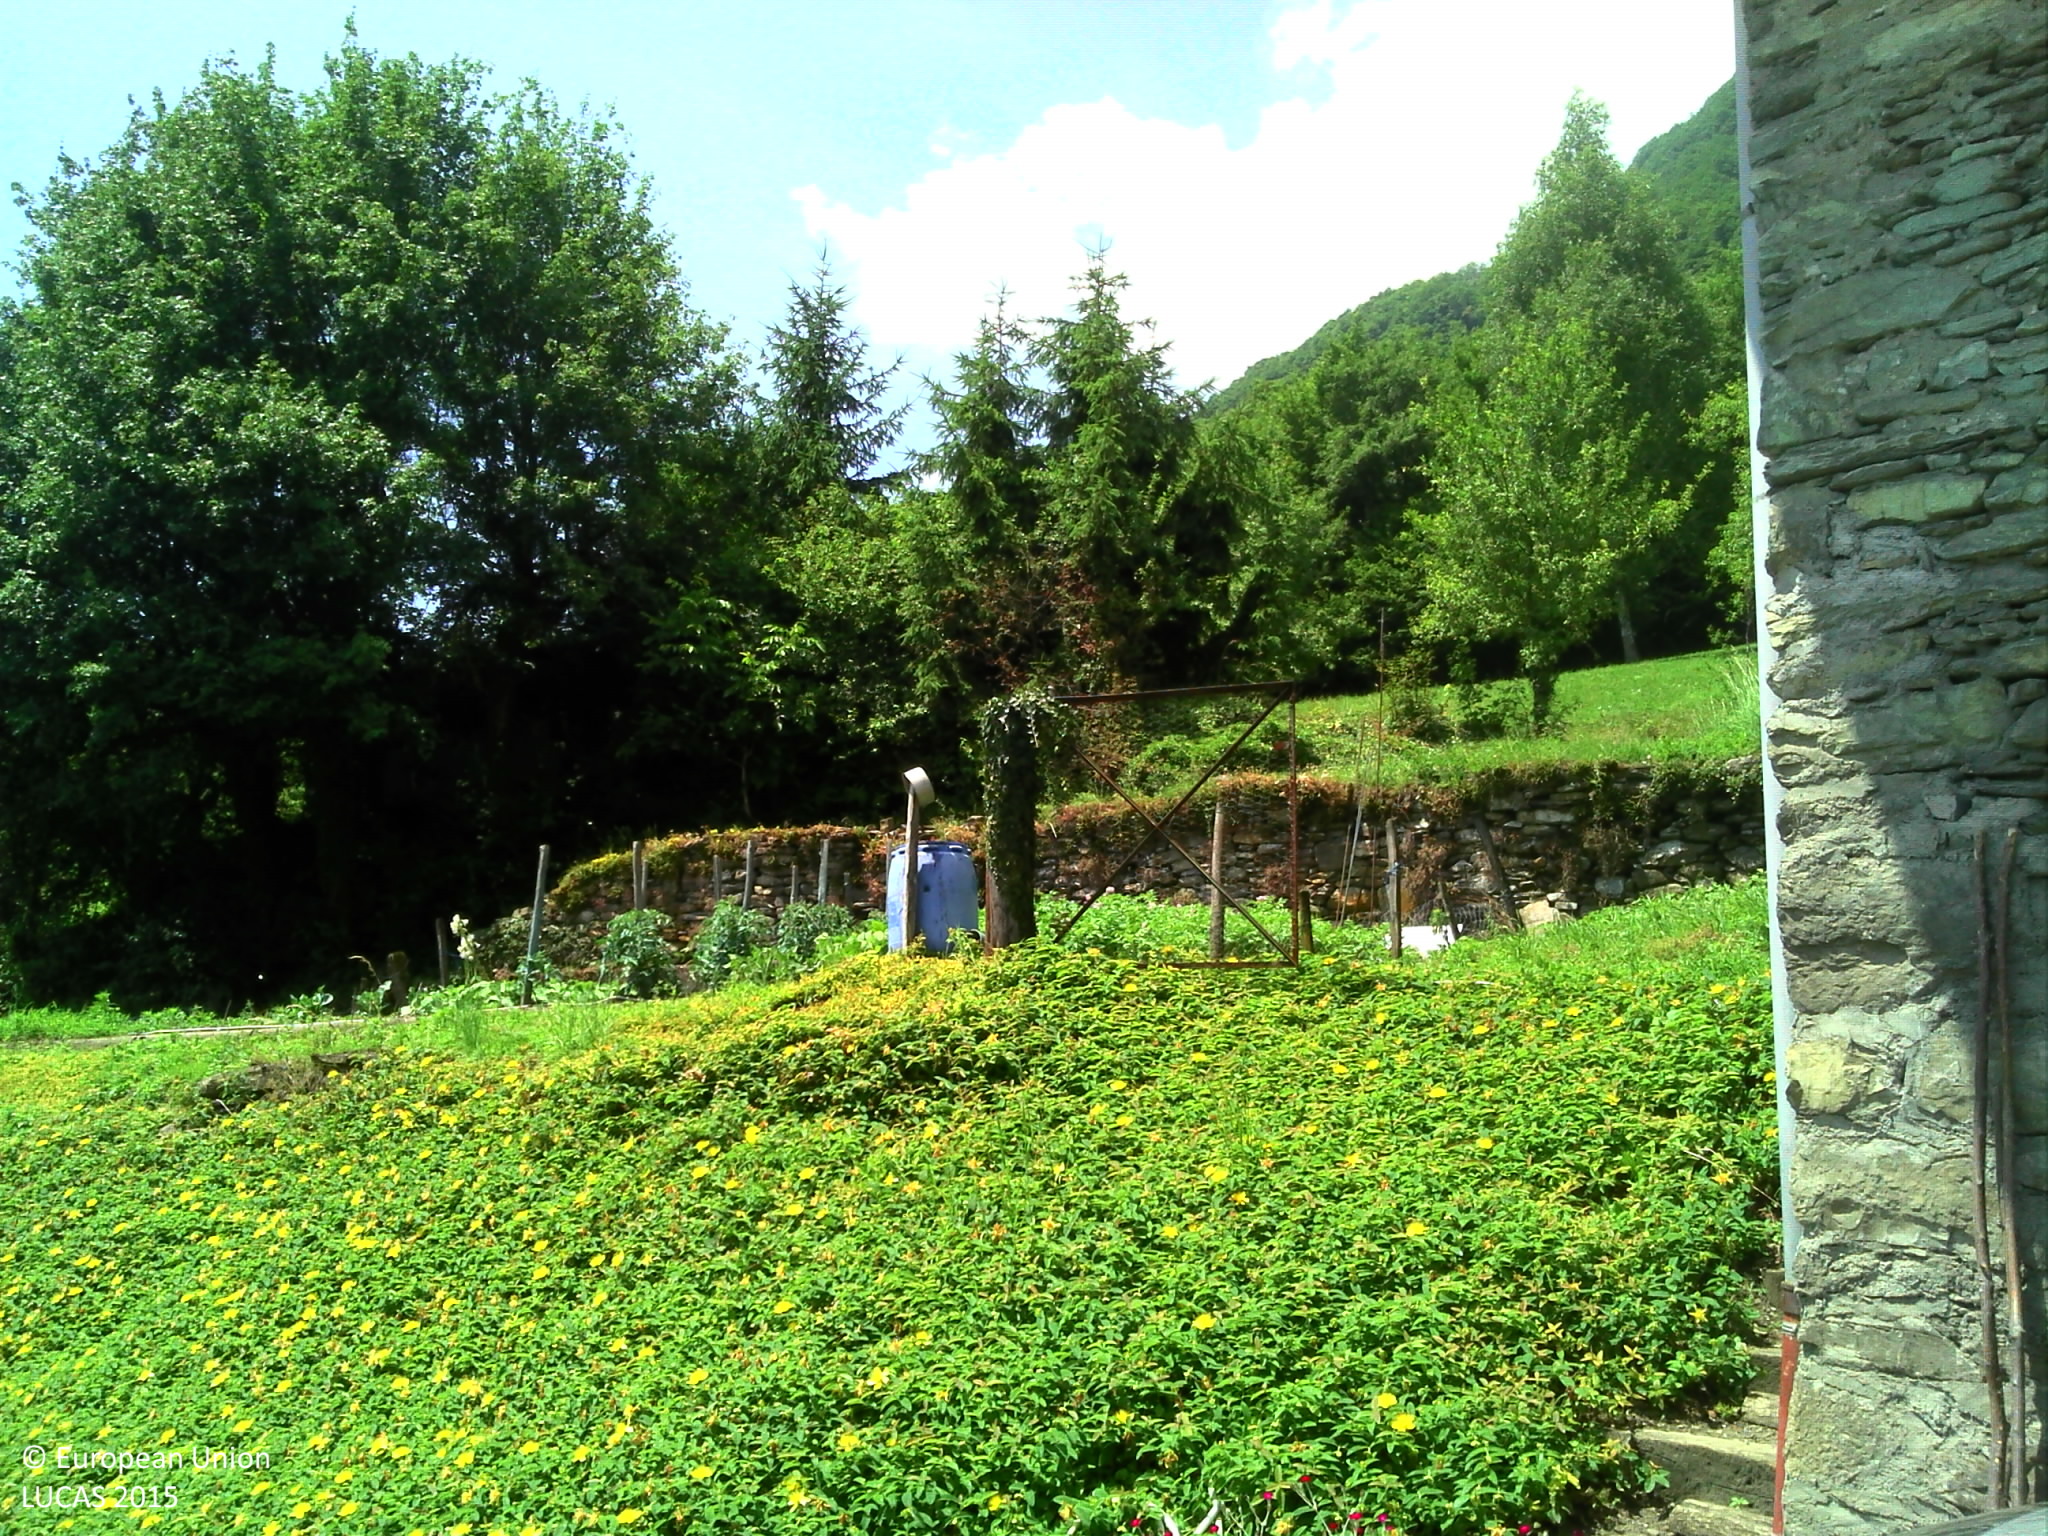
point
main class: Woodland
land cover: Broadleaved woodland
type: mountainous beech forest
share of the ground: > 75 %
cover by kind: broadleaved forest trees 100 %
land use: Forestry
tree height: > 5 m
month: June
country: FR
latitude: 45.5992
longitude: 6.2225
